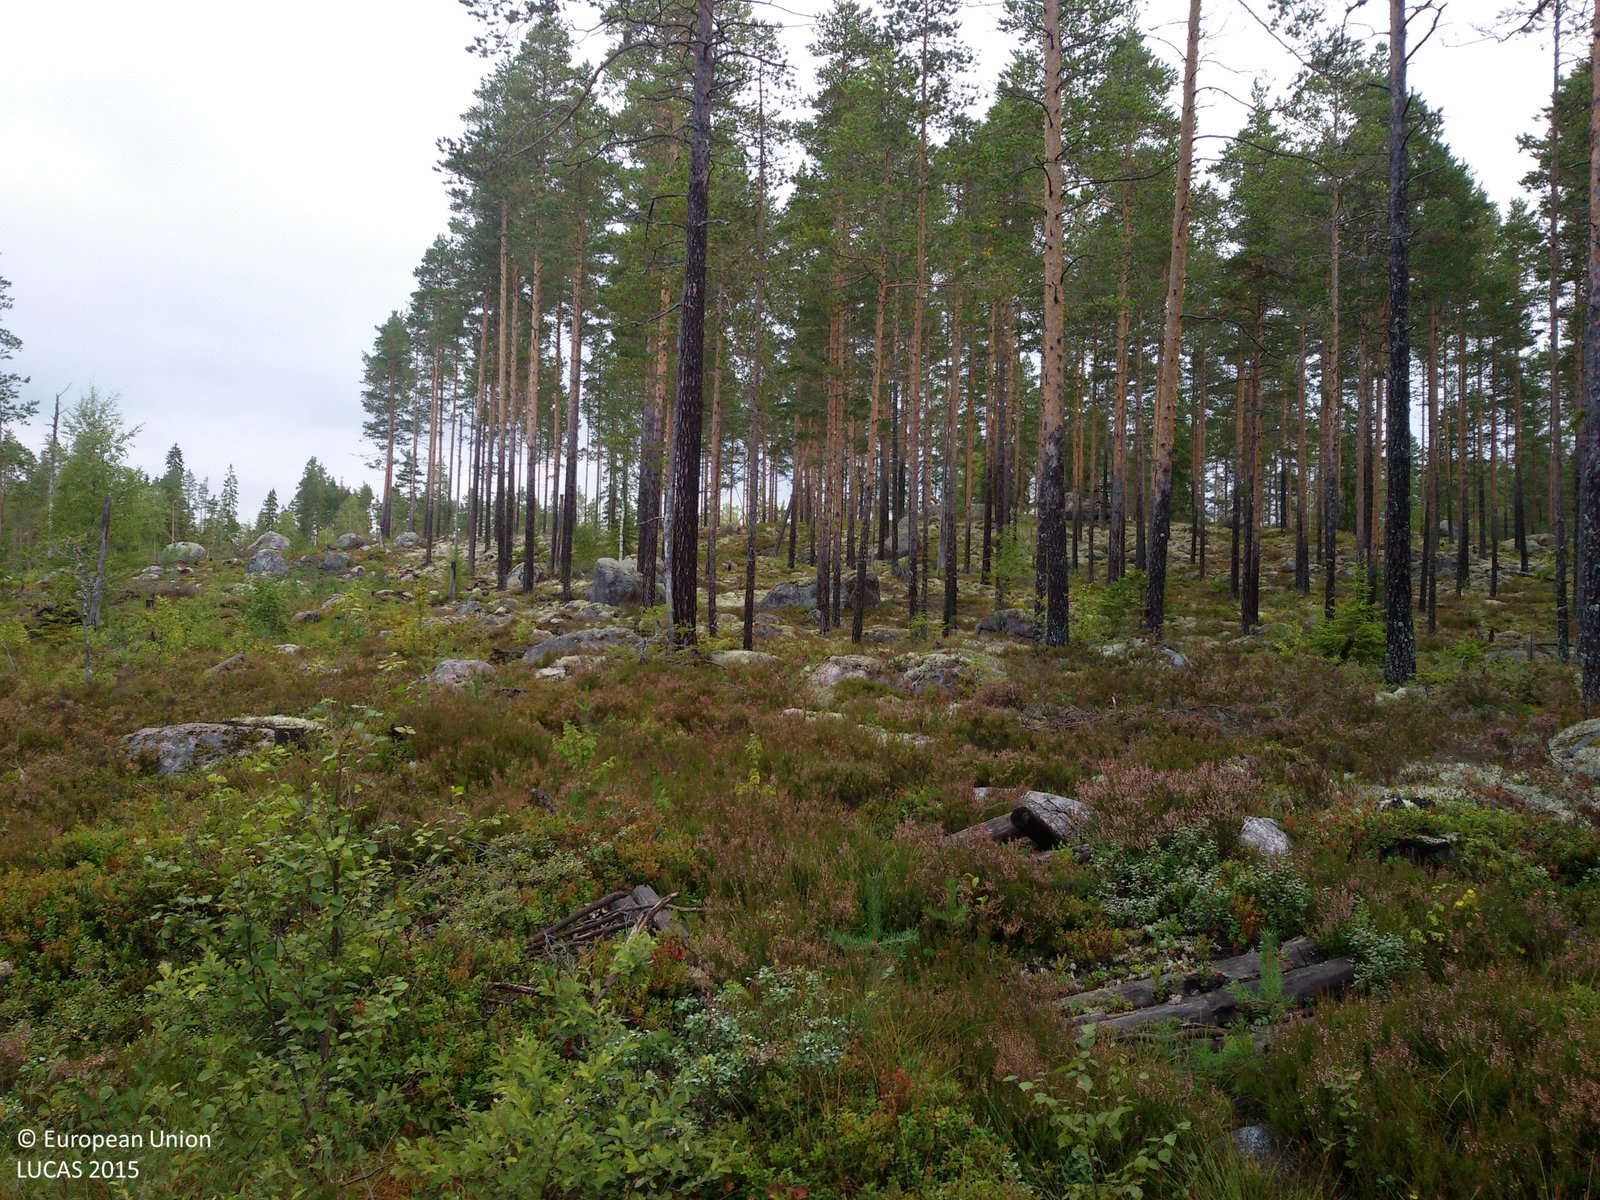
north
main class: Woodland
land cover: Pine dominated mixed woodland
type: boreal forest
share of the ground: 50 - 75 %
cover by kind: herbaceous plants 40 %, coniferous forest trees 30 %, broadleaved forest trees 30 %
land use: Forestry
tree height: > 5 m
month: September
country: SE
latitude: 61.0724
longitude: 15.3417
